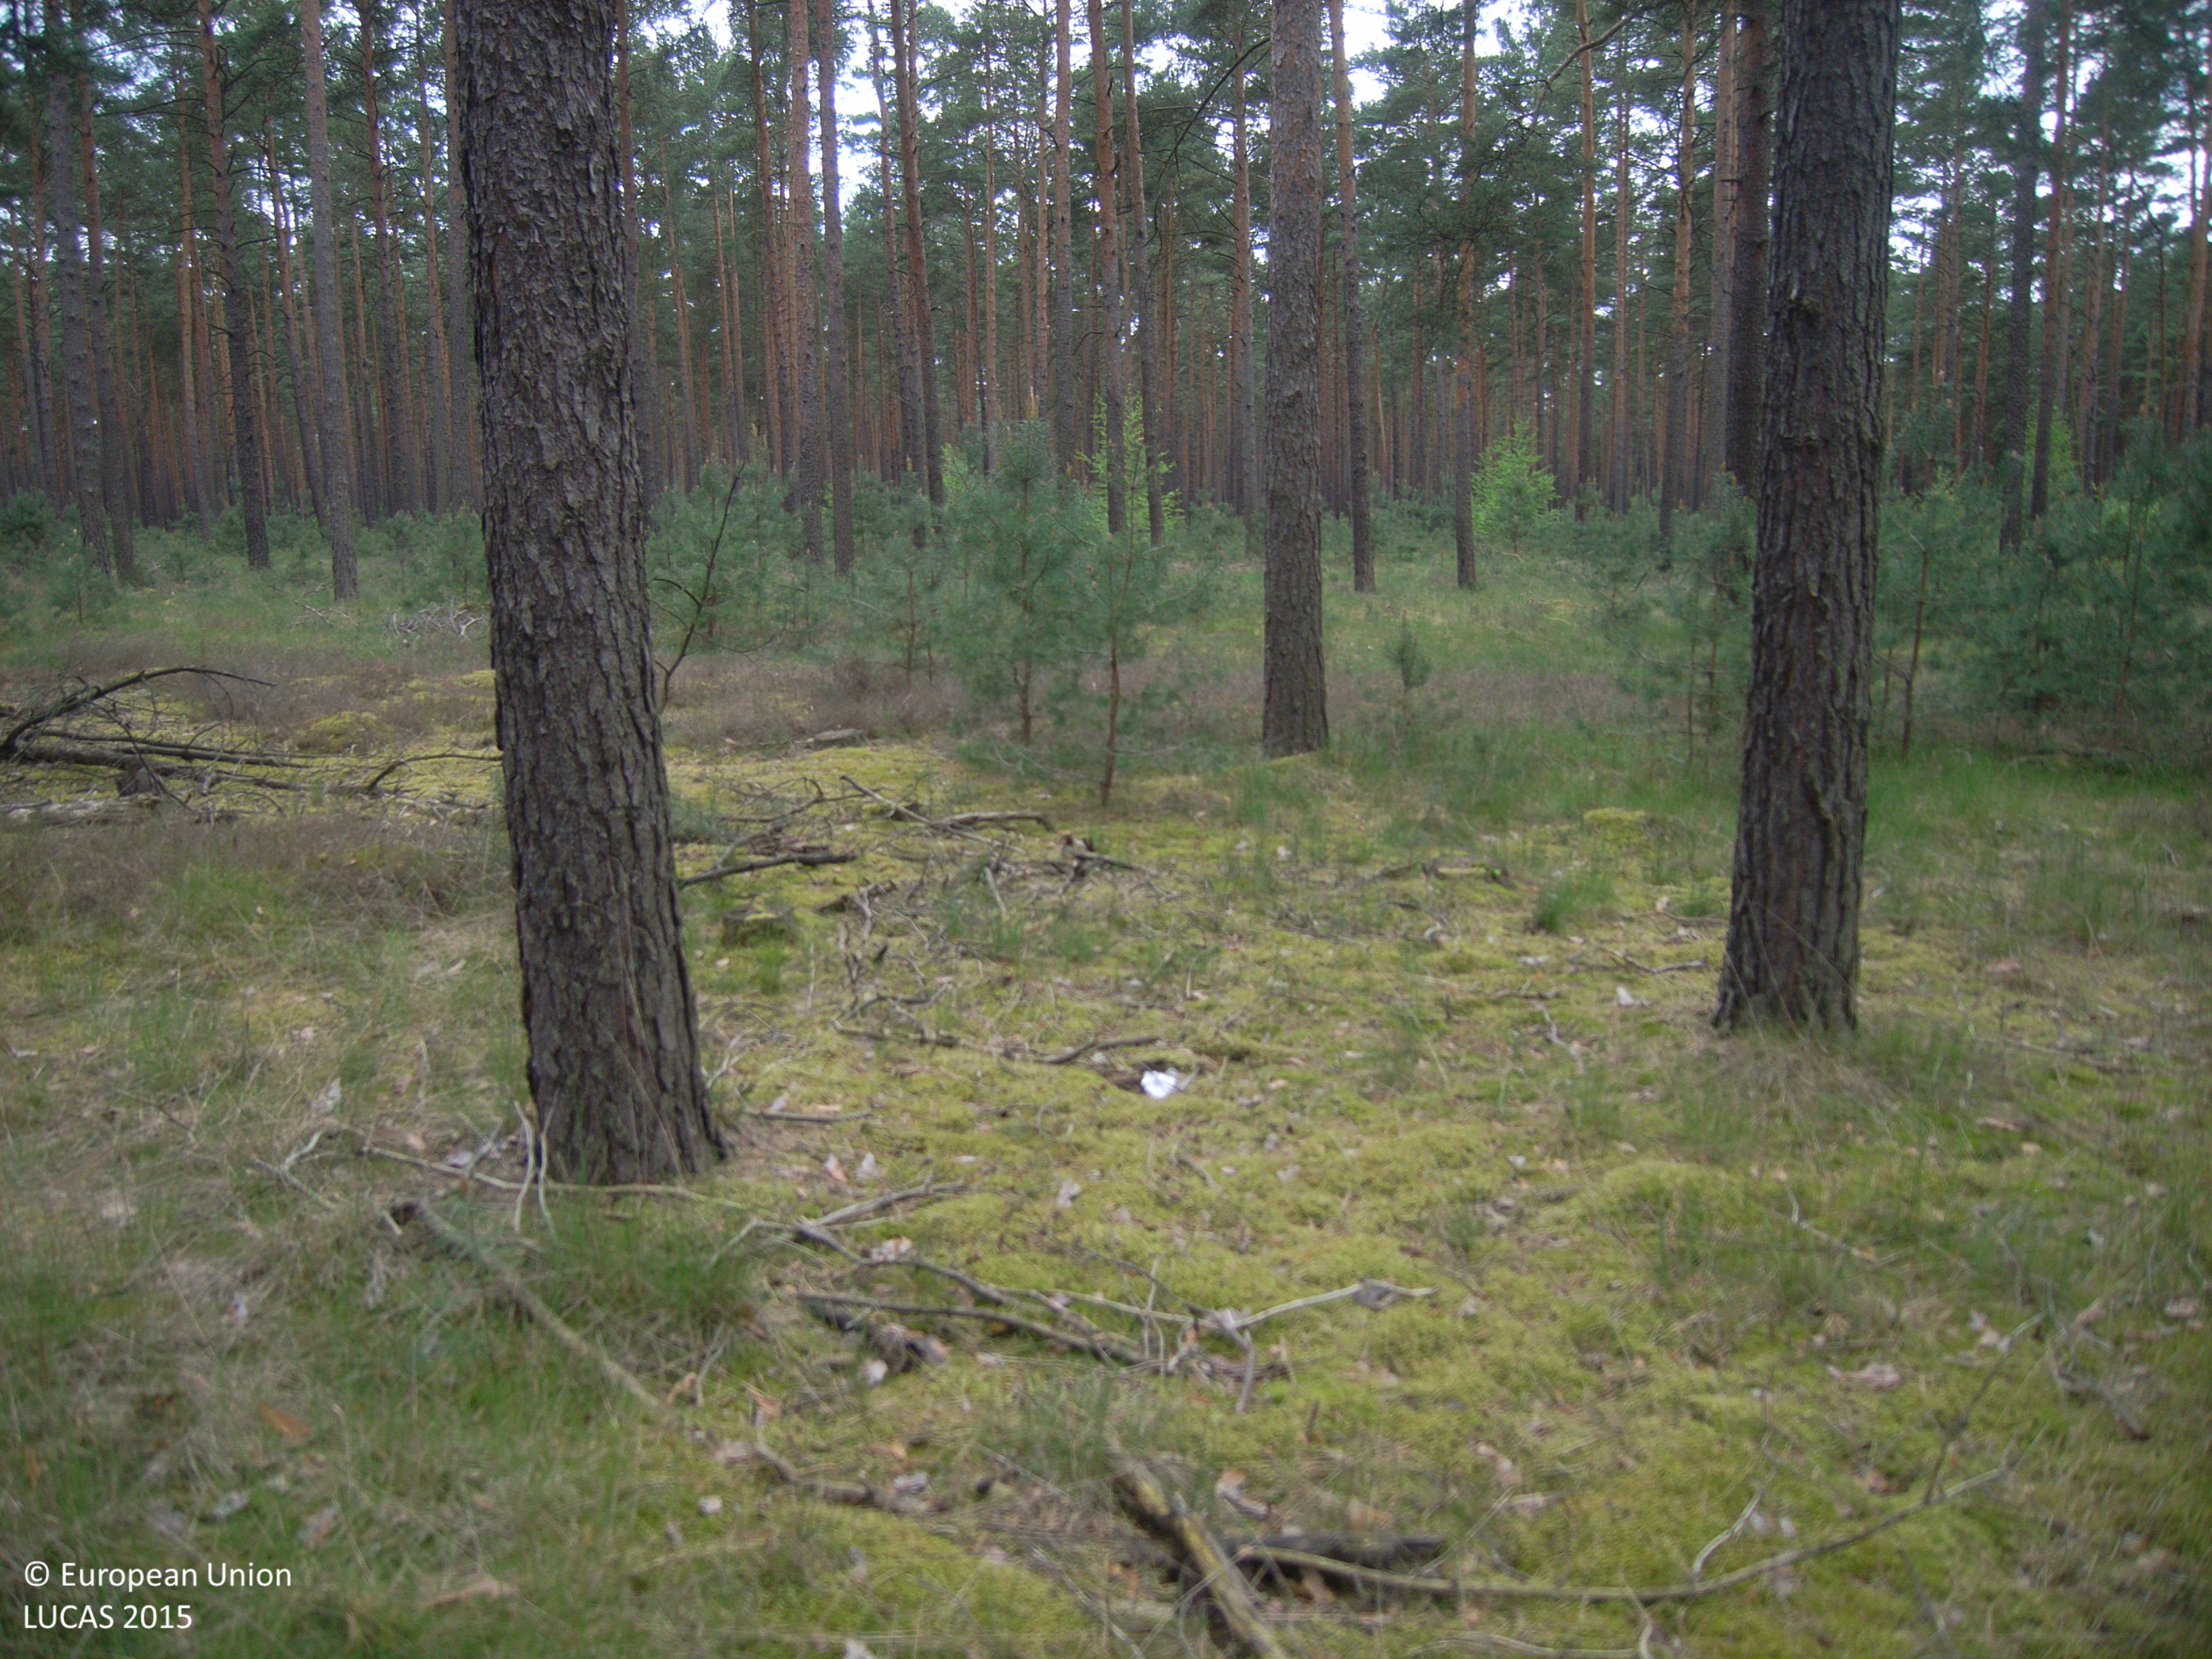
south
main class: Woodland
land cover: Pine dominated coniferous woodland
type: hemiboreal forest and nemoral coniferous forest and mixed broadleaved-coniferous forest
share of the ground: > 75 %
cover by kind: coniferous forest trees 100 %
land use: Forestry
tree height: > 5 m
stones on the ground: < 10 %
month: May
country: DE
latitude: 52.0898
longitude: 13.5762
